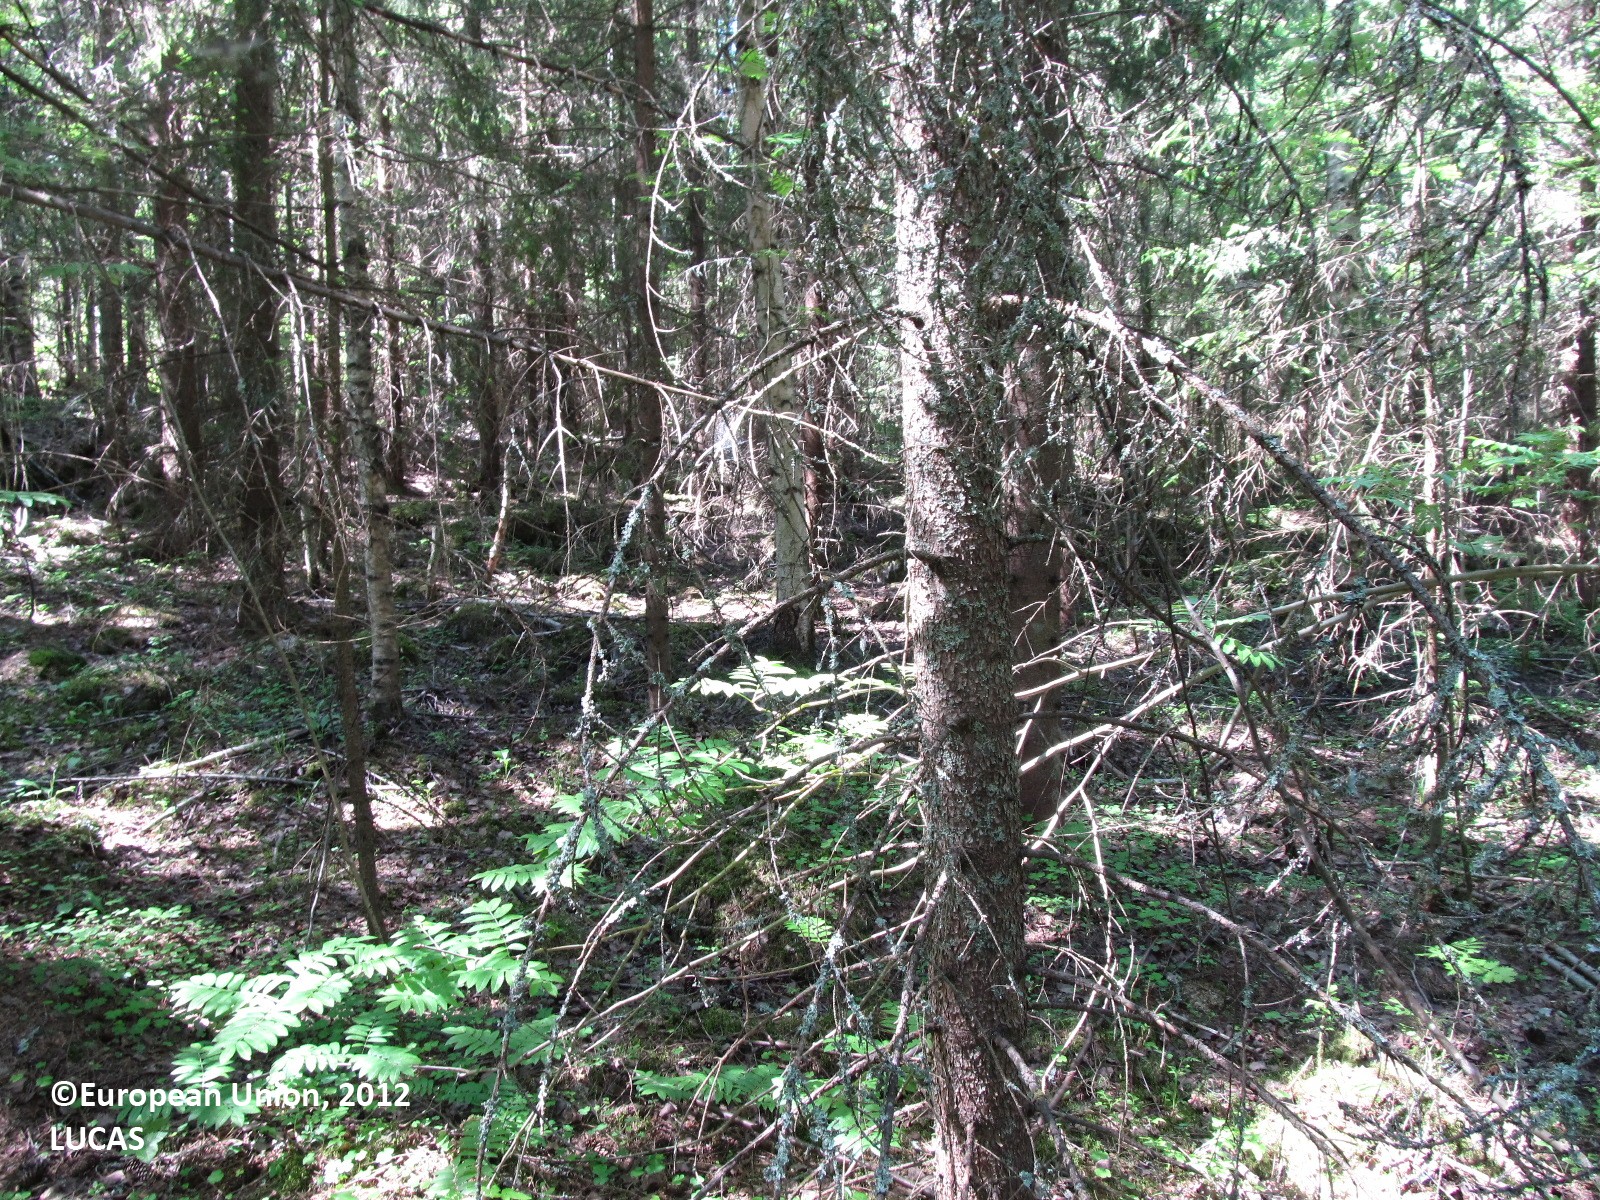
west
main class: Woodland
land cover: Spruce dominated coniferous woodland
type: boreal forest
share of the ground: 50 - 75 %
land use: Forestry
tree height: > 5 m
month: June
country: FI
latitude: 63.0317
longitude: 27.7402
